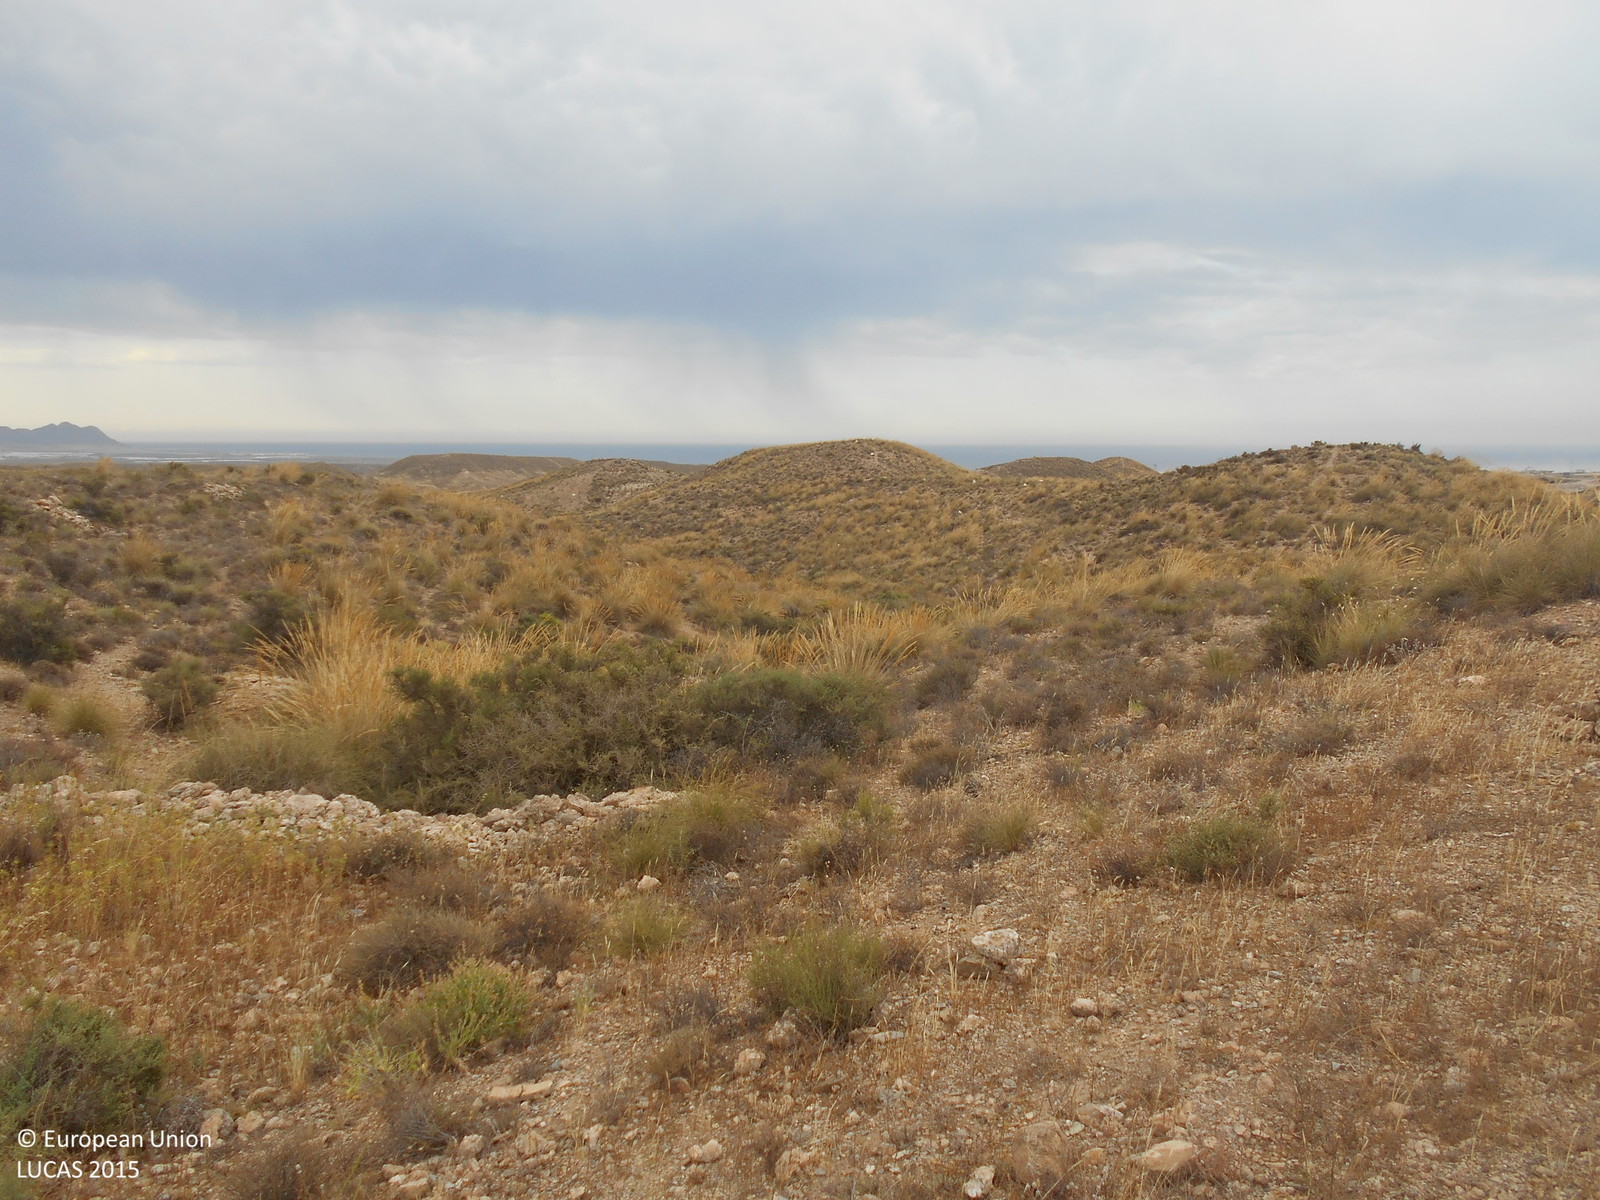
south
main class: Shrubland
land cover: Shrubland without tree cover
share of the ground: 10 - 25 %
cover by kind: unconsolidated bare surface 40 %, herbaceous plants 30 %, shrubs 20 %, consolidated bare surface 10 %
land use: Semi-natural and natural areas not in use
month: May
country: ES
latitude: 36.8928
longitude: -2.2846
